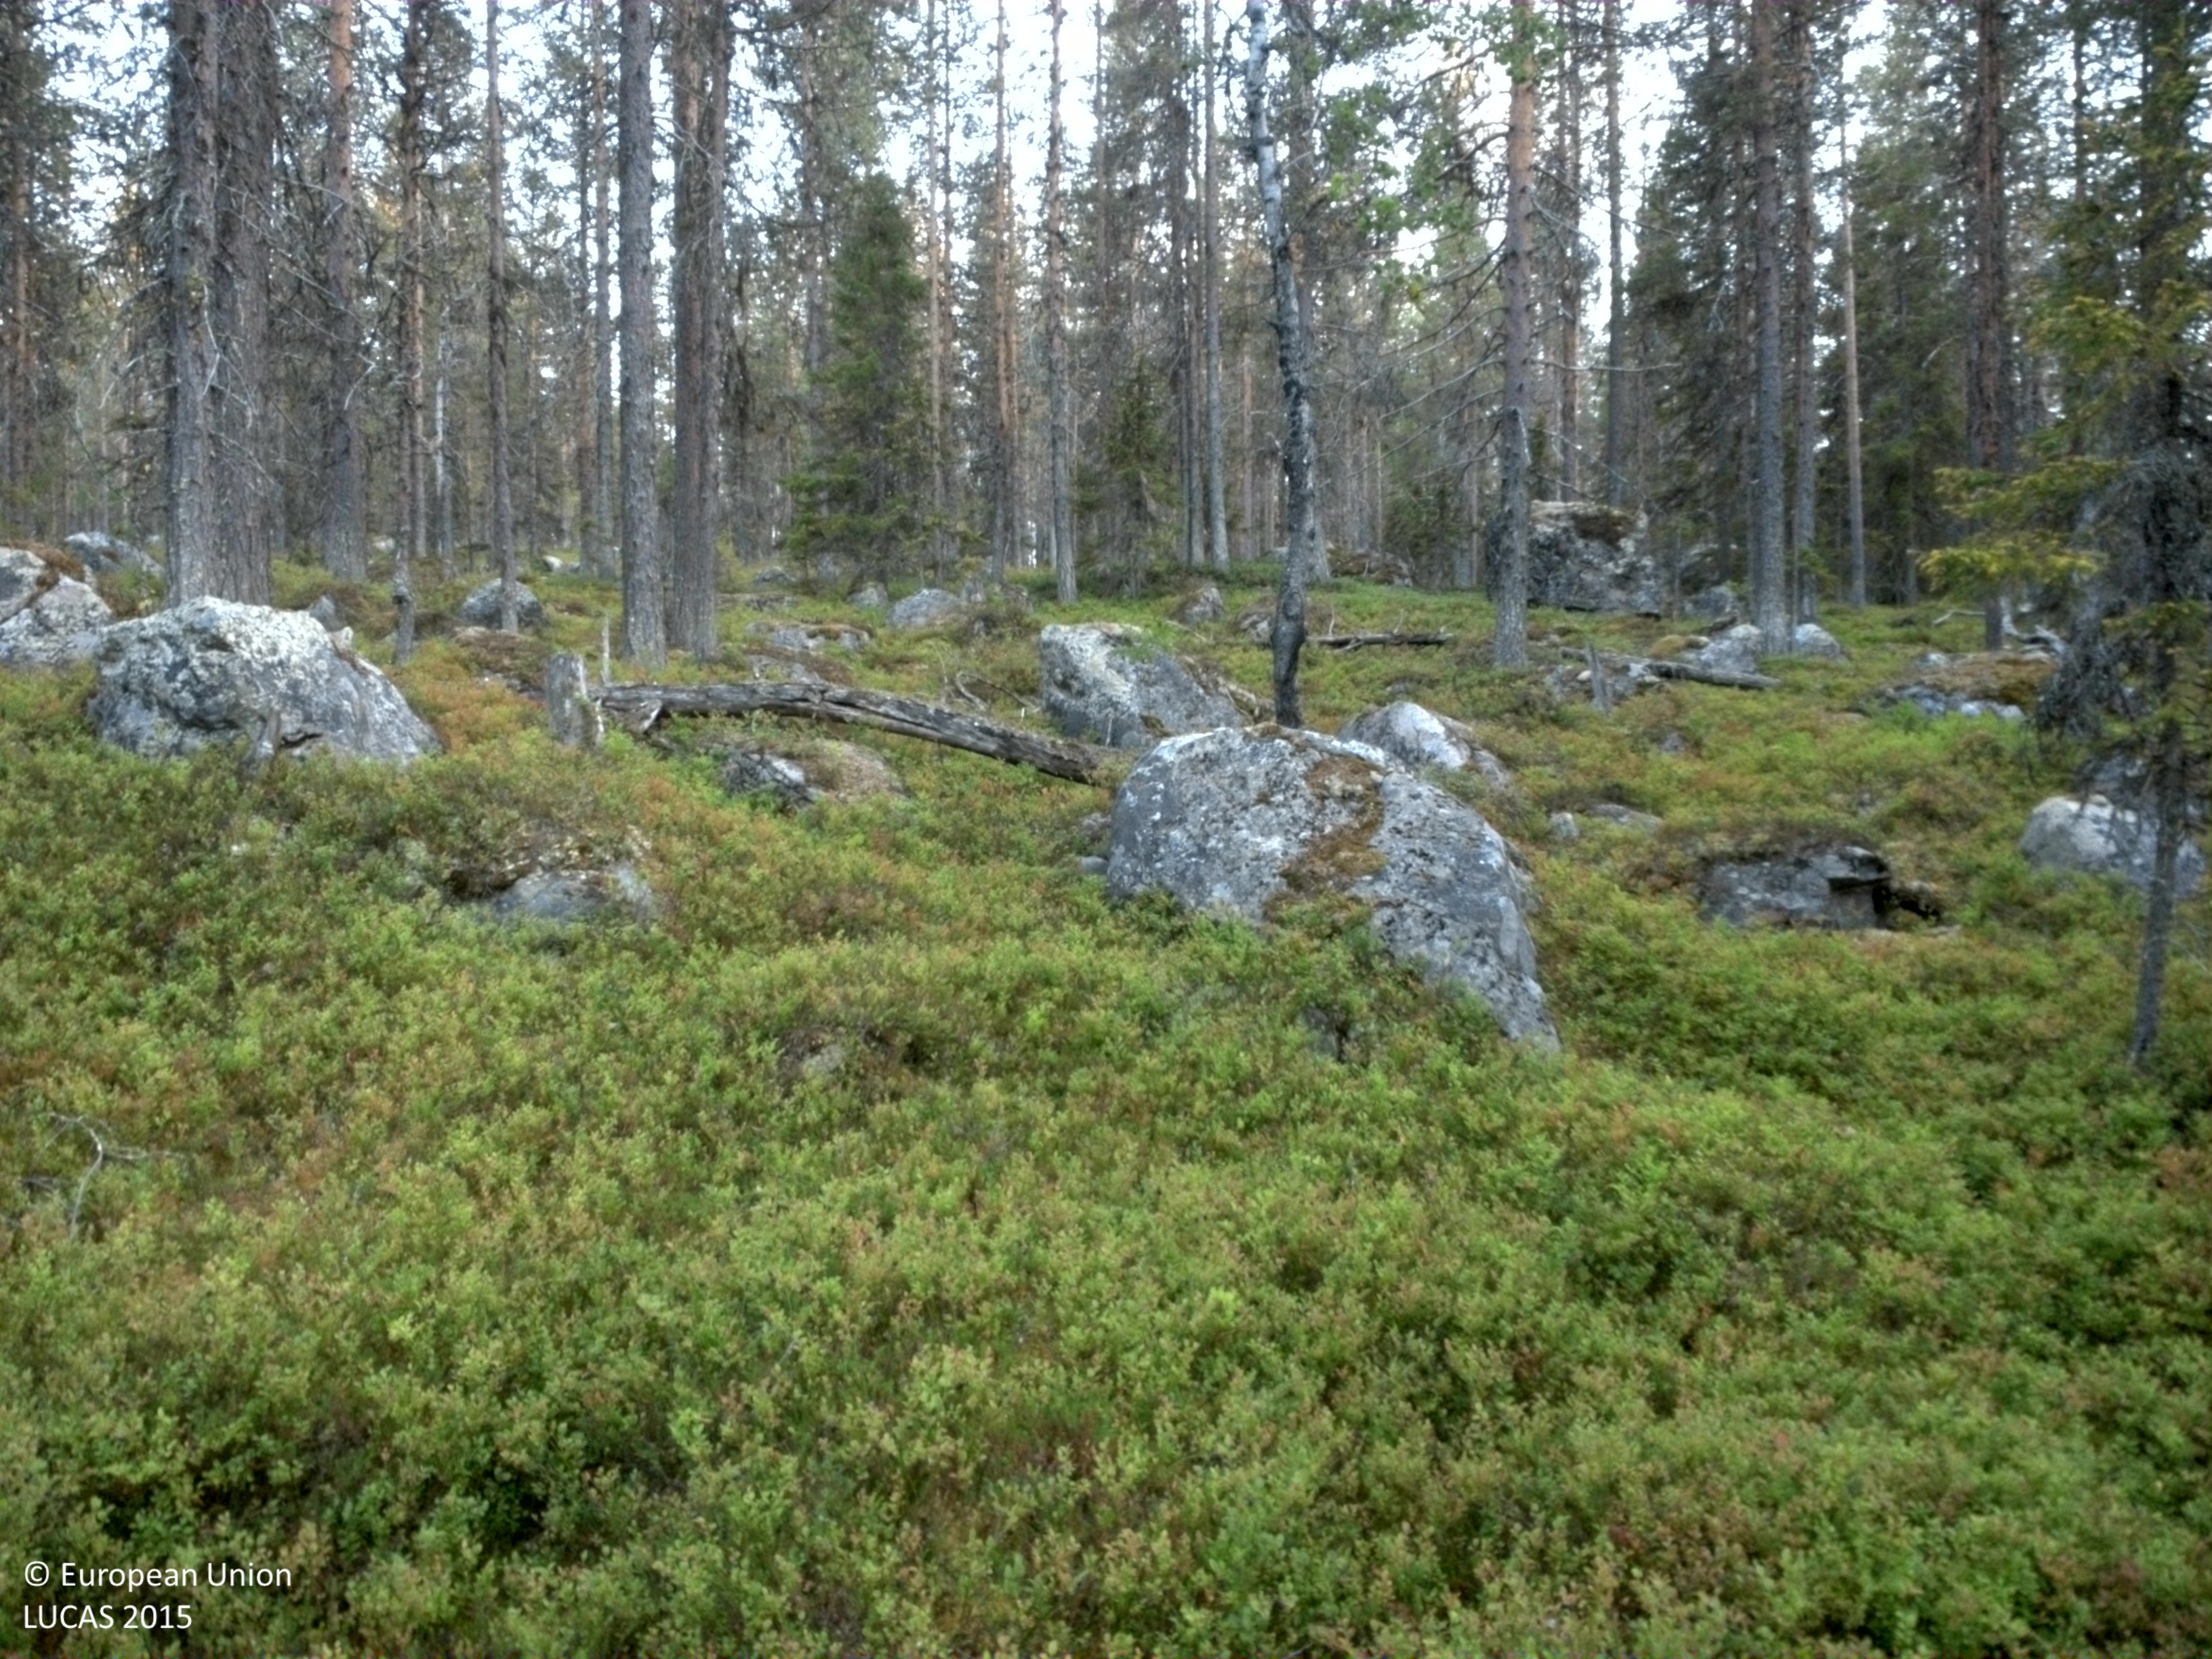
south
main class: Woodland
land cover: Pine dominated coniferous woodland
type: boreal forest
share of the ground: 10 - 25 %
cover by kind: shrubs 65 %, coniferous forest trees 20 %, lichens and mosses 10 %, consolidated bare surface 5 %
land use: Forestry
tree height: > 5 m
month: September
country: SE
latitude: 65.1613
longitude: 17.5791
